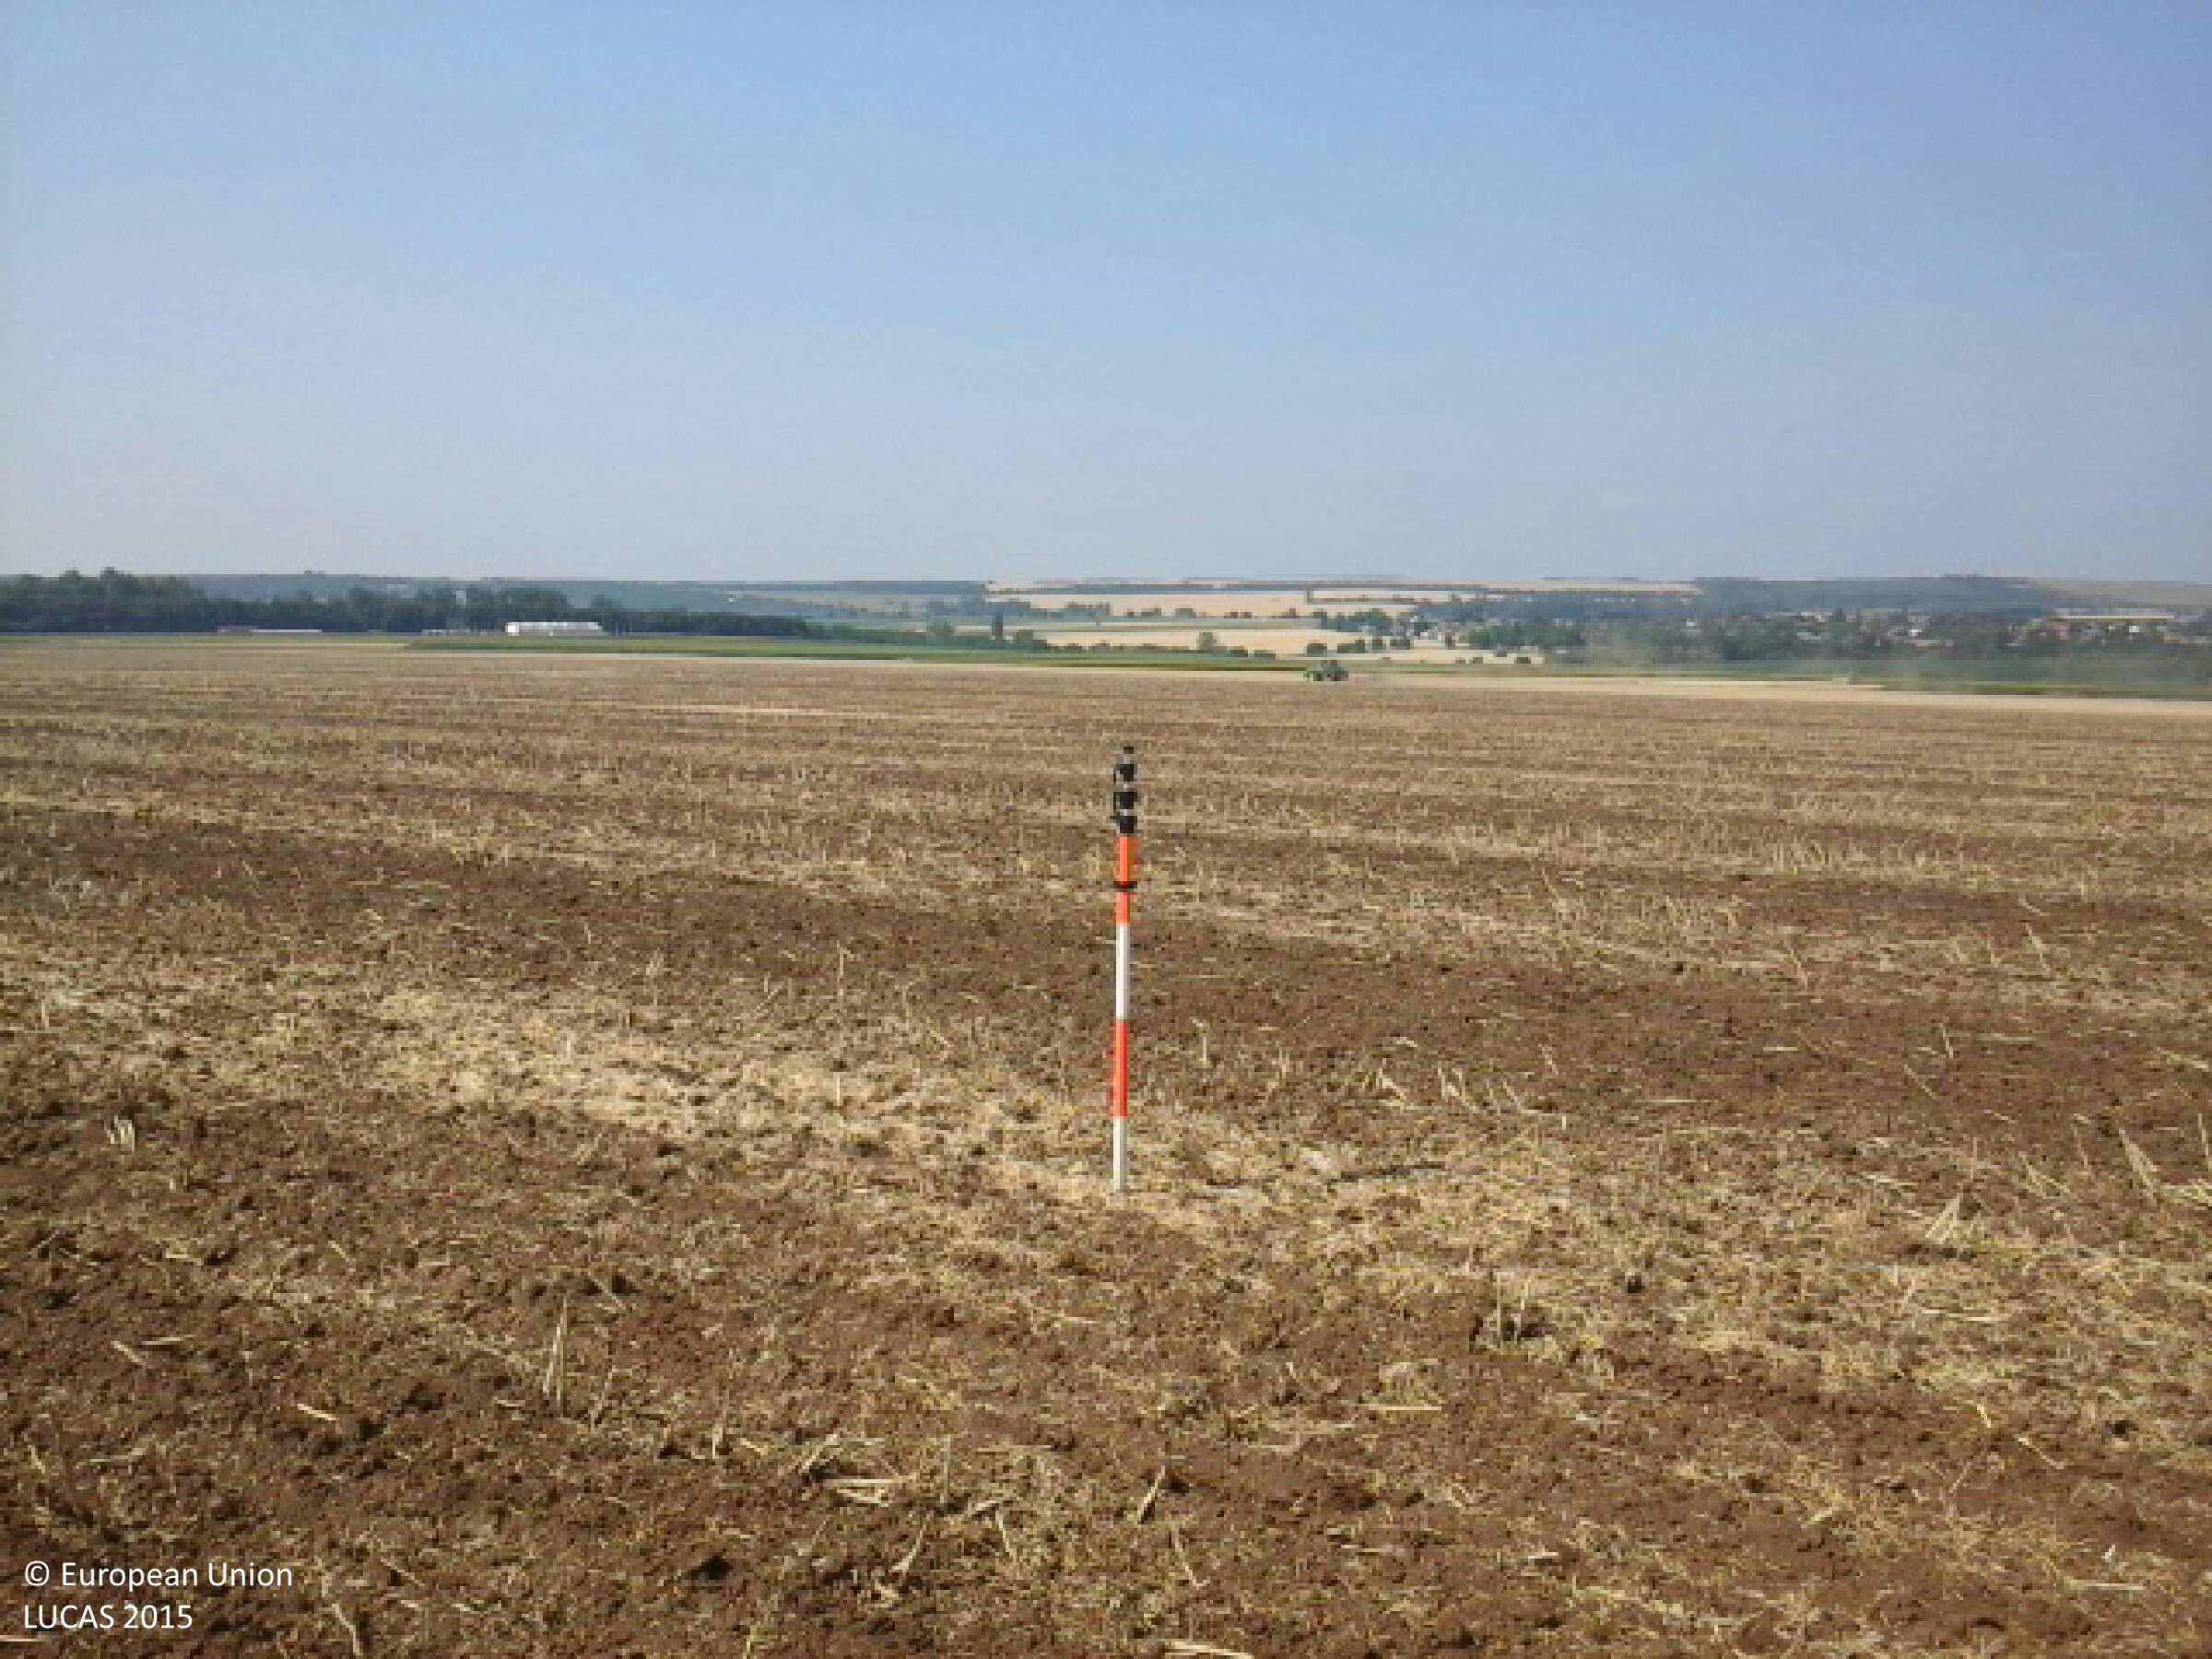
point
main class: Cropland
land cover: Rape and turnip rape
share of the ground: < 10 %
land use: Agriculture (excluding fallow land and kitchen gardens)
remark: Harvested field
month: July
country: HU
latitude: 48.1894
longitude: 21.0845
